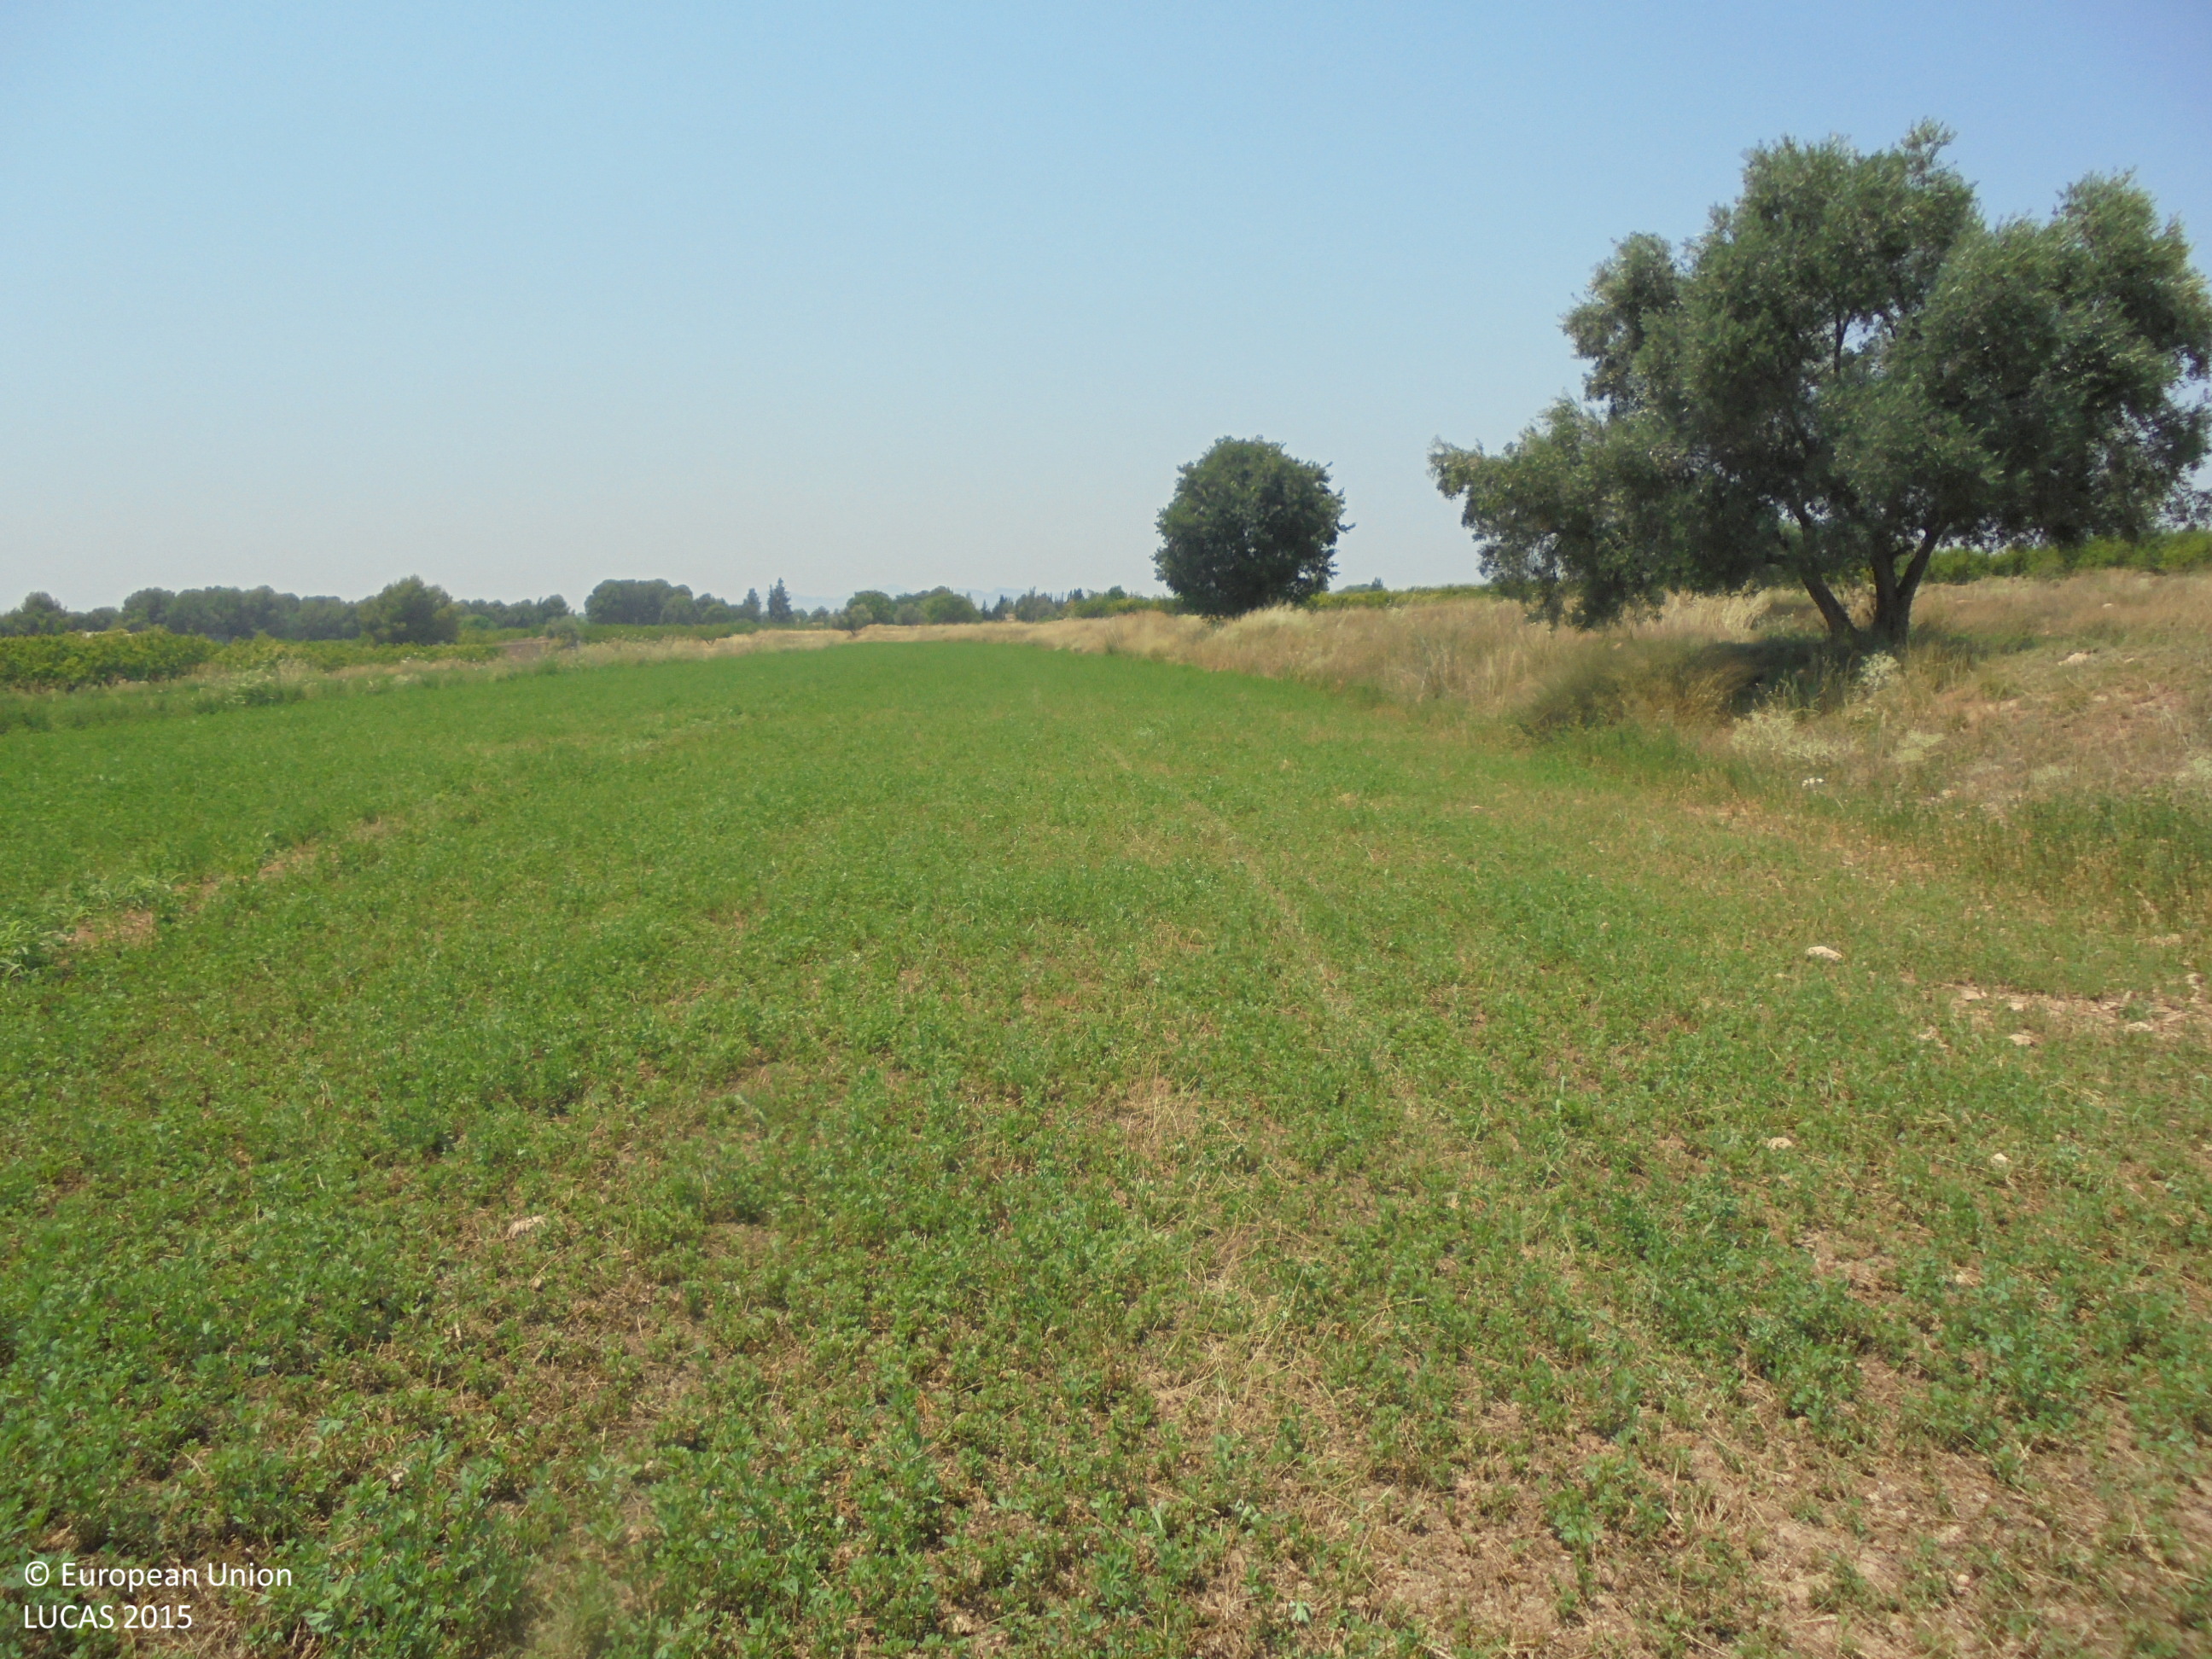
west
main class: Cropland
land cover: Lucerne
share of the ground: 25 - 50 %
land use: Agriculture (excluding fallow land and kitchen gardens)
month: July
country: ES
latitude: 38.4895
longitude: -1.6755
